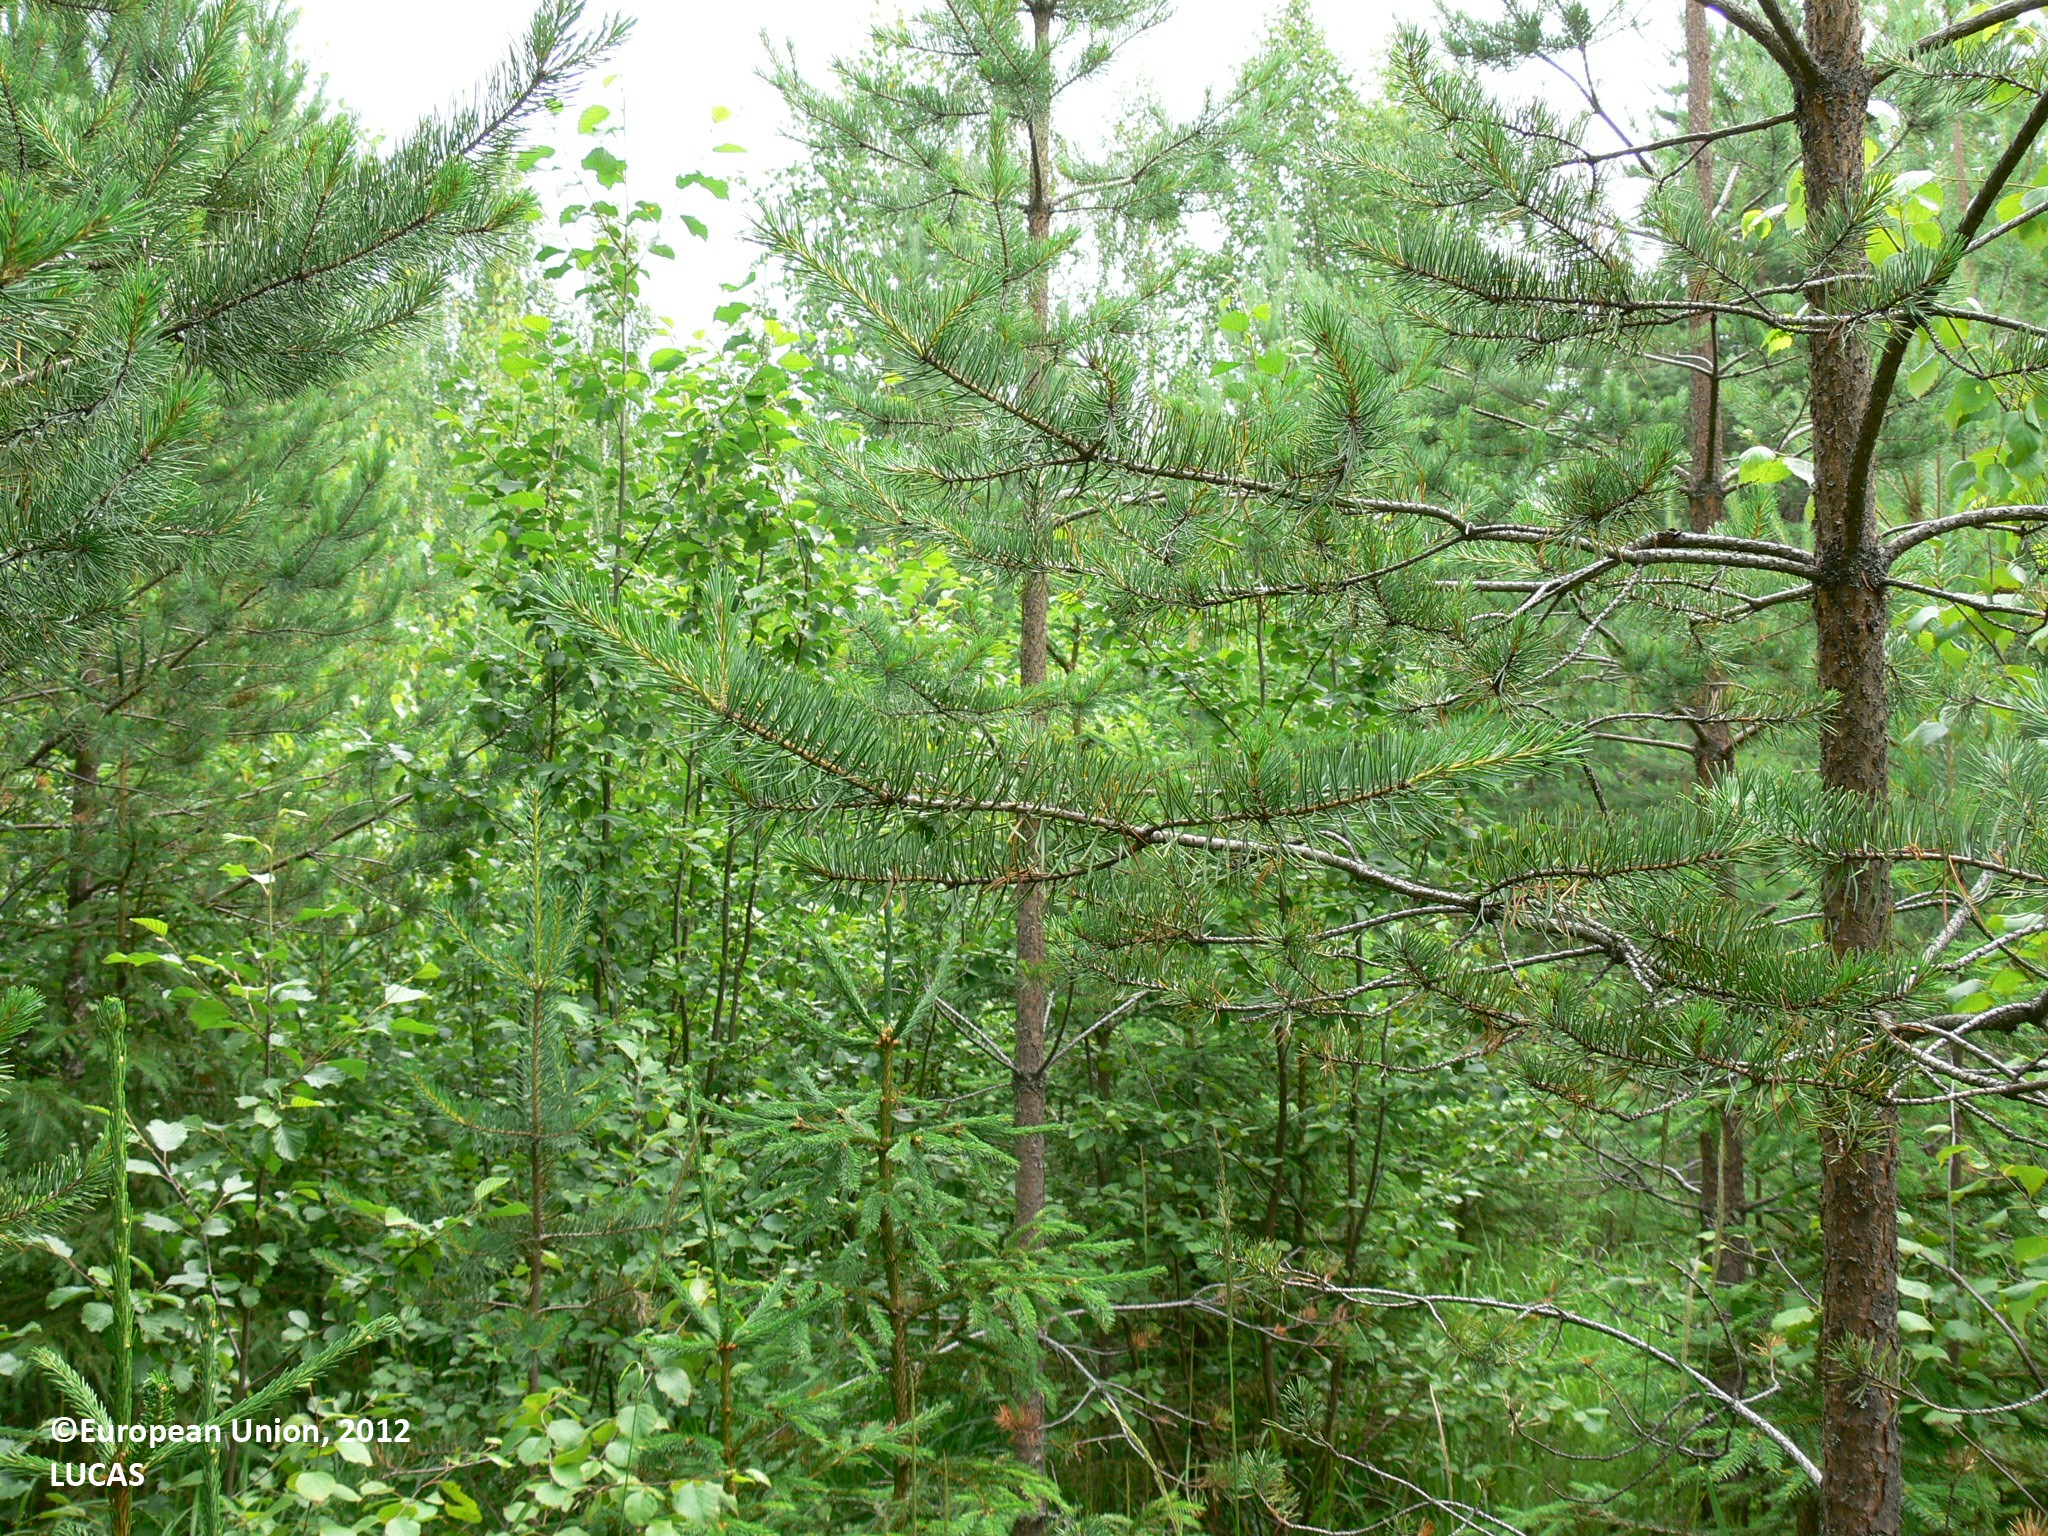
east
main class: Woodland
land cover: Pine dominated mixed woodland
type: boreal forest
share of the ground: > 75 %
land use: Forestry
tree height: > 5 m
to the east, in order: Pine dominated mixed woodland; Grass margins; Ditches and canals; Shruby margins; Paved roads, cycling and walking lanes; Grass margins; Paved roads, cycling and walking lanes; Grass margins; Other mixed woodland; Pine dominated coniferous woodland; Other mixed woodland
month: July
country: FI
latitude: 63.0011
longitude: 29.4837
